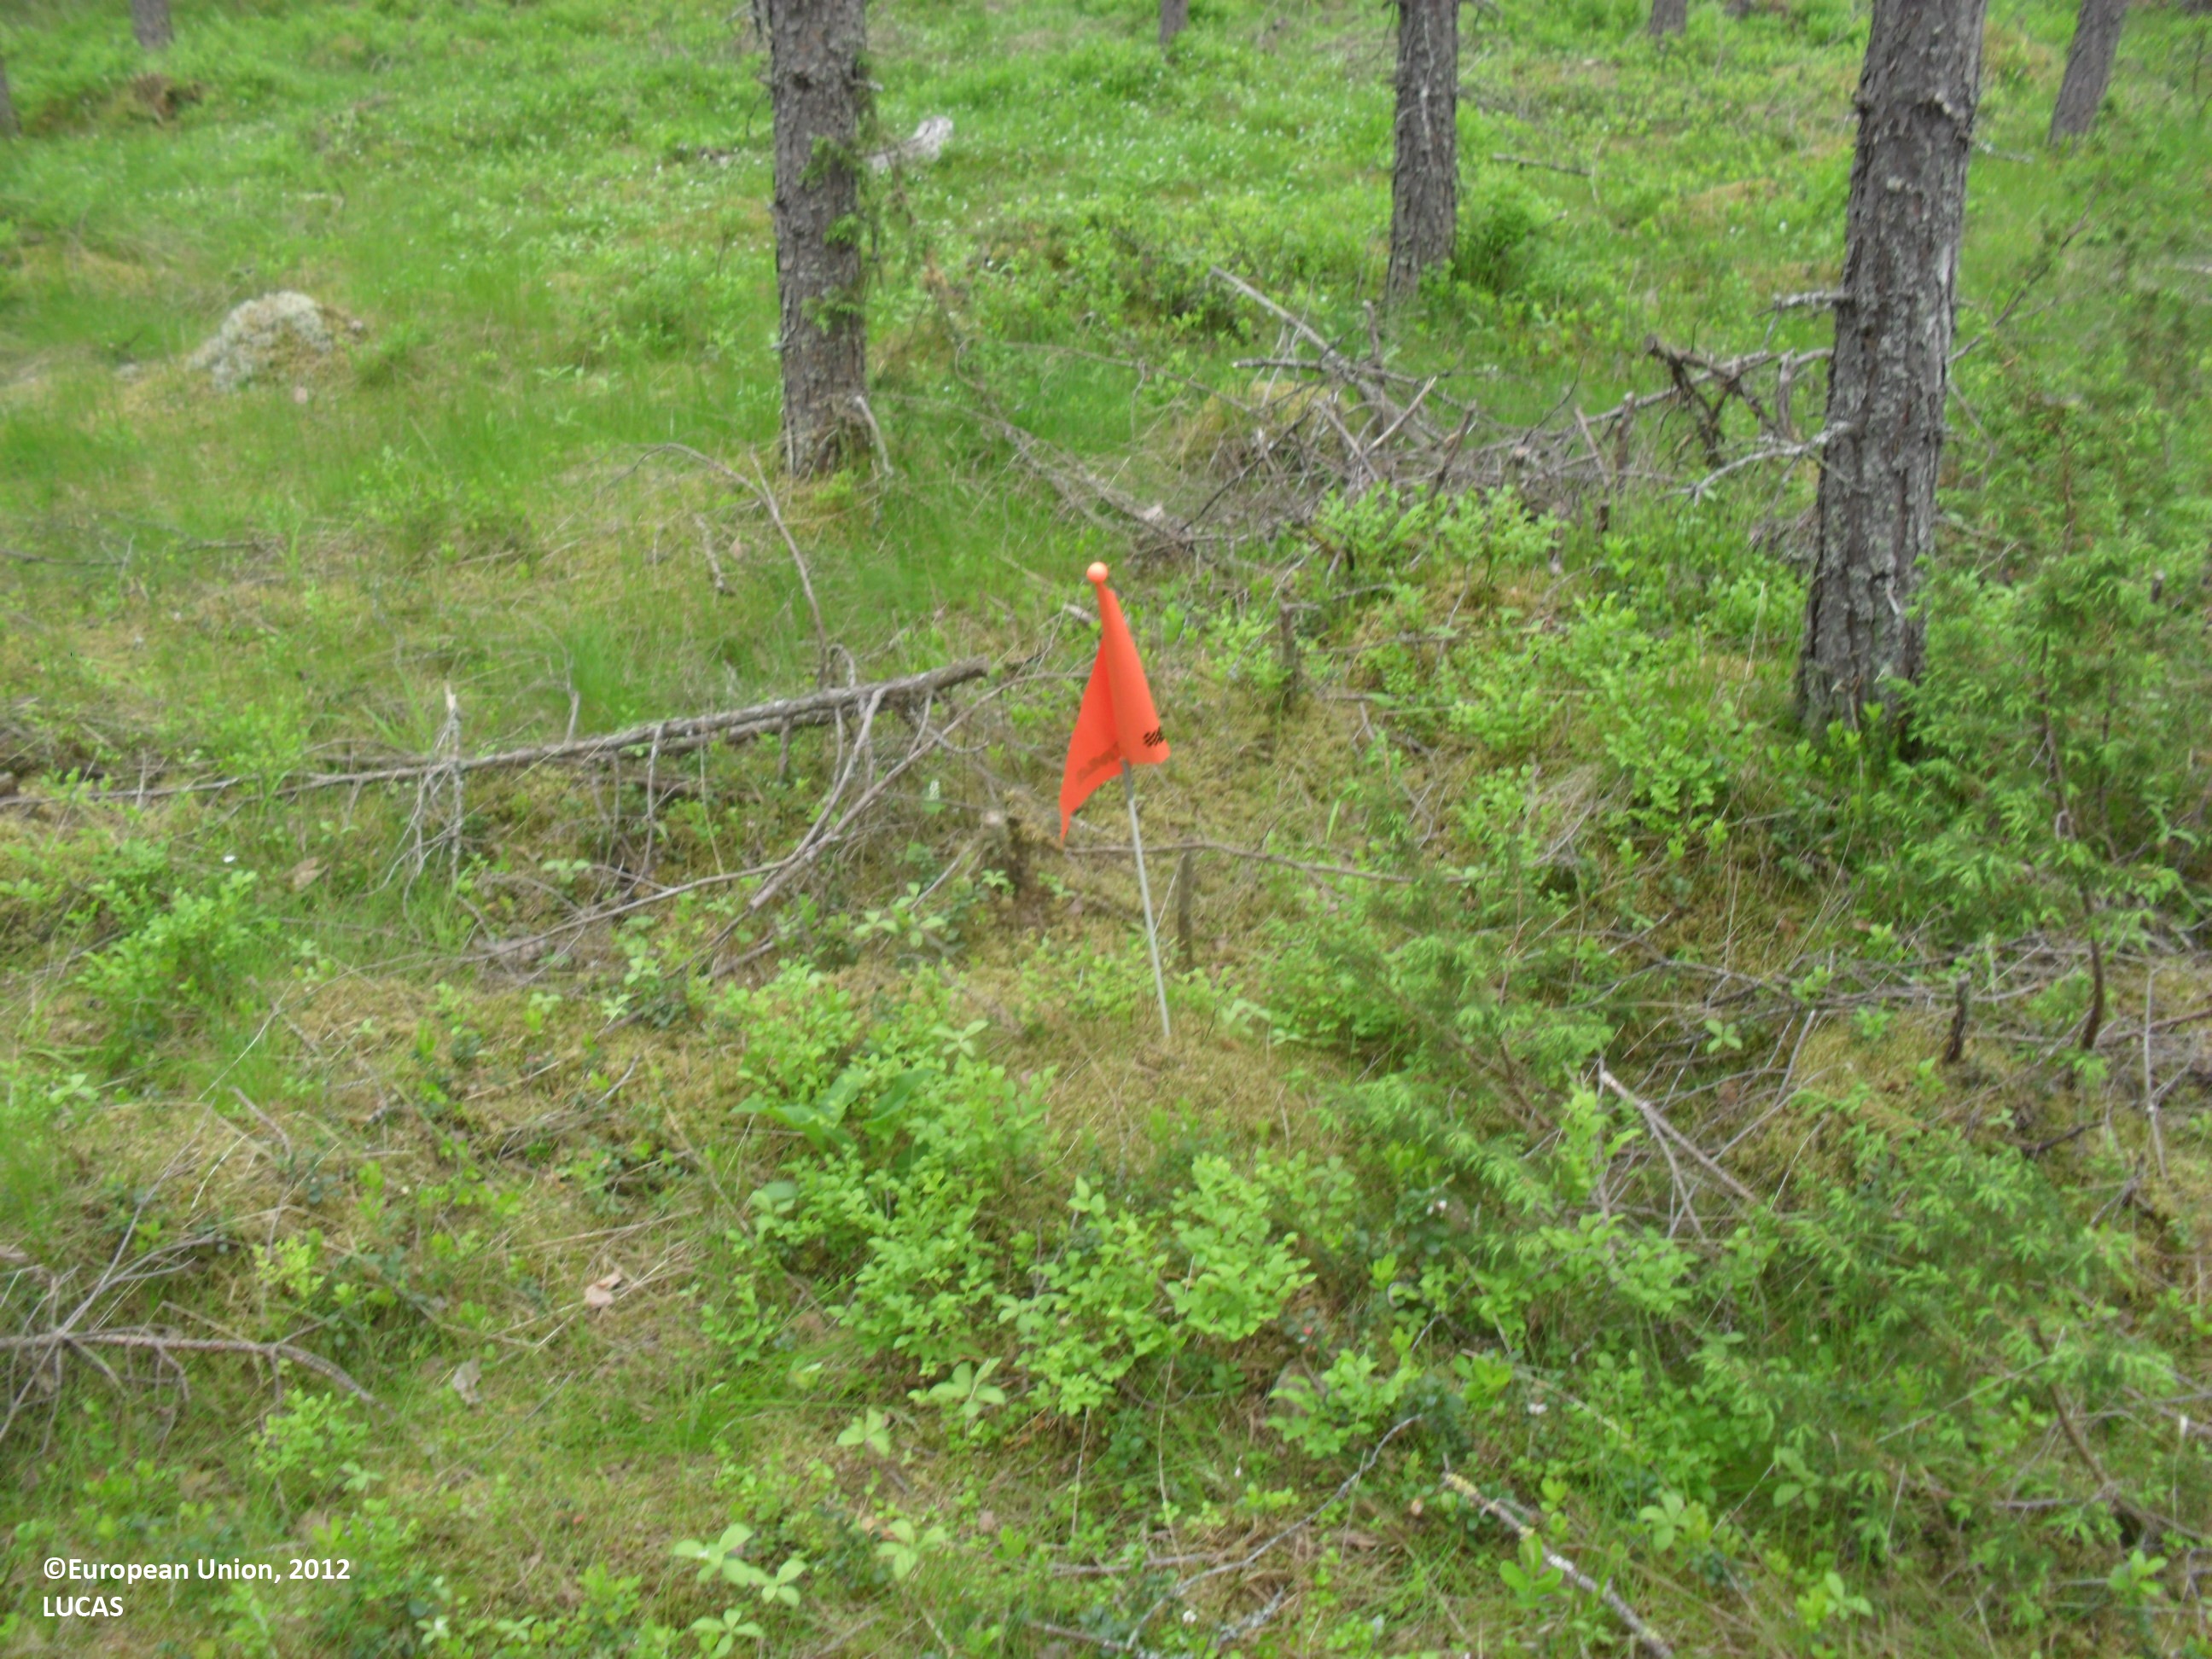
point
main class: Woodland
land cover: Pine dominated coniferous woodland
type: boreal forest
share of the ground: 25 - 50 %
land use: Forestry
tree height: > 5 m
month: June
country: FI
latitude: 63.4941
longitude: 23.2122
